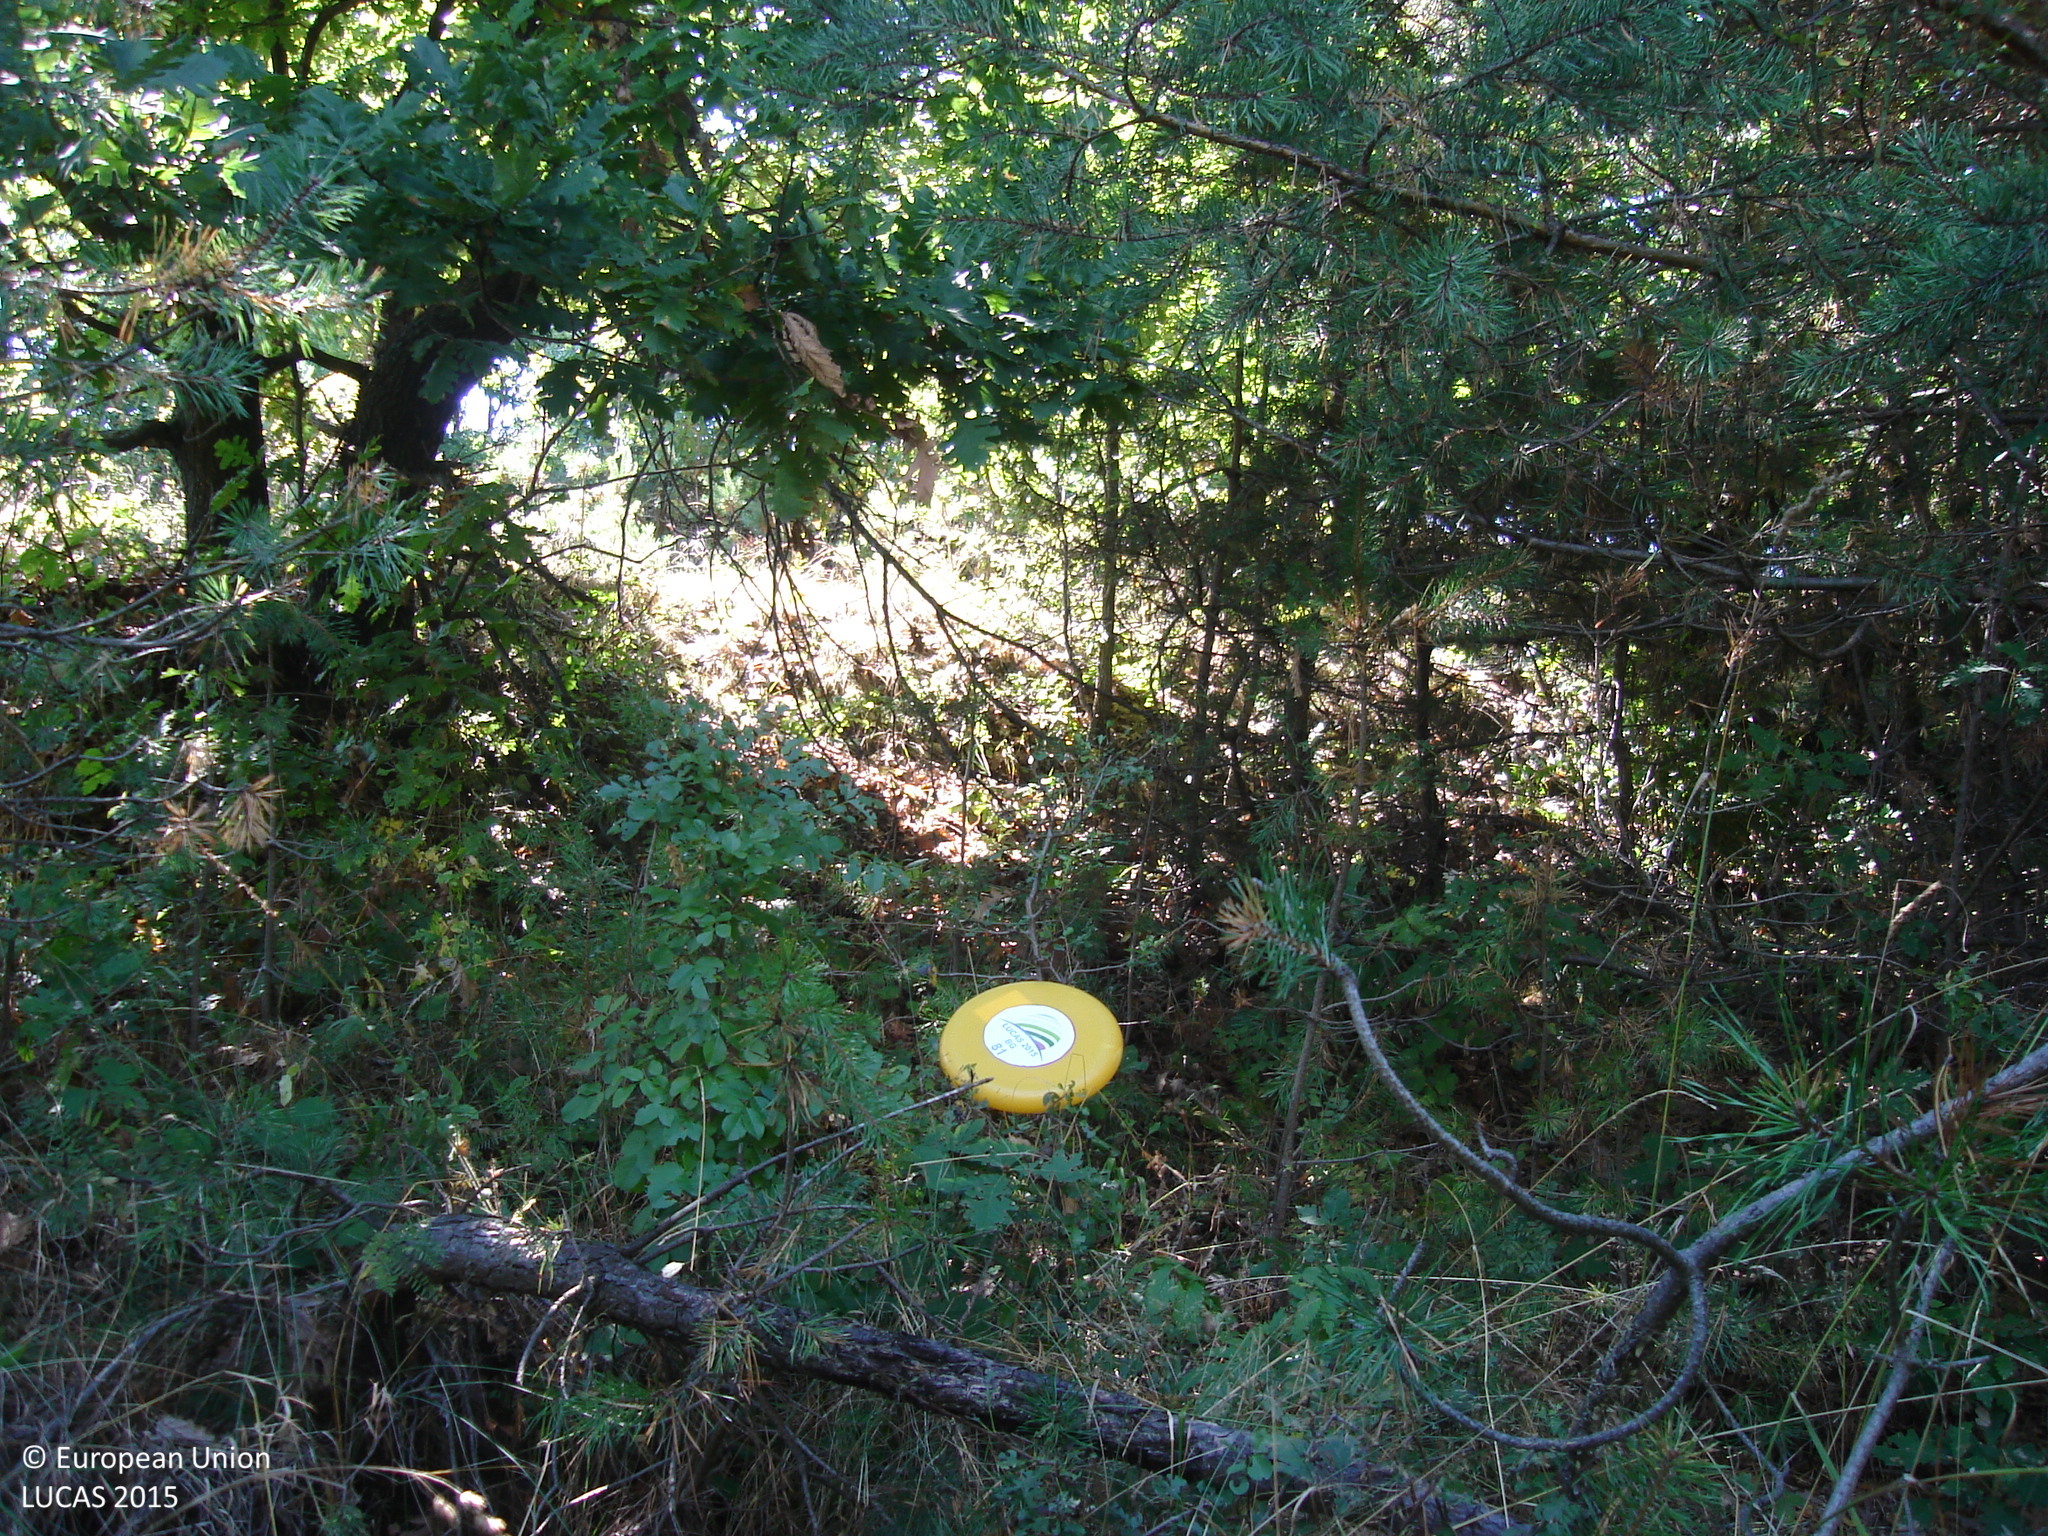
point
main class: Woodland
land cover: Pine dominated mixed woodland
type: hemiboreal forest and nemoral coniferous forest and mixed broadleaved-coniferous forest
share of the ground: > 75 %
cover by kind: coniferous forest trees 55 %, herbaceous plants 25 %, broadleaved forest trees 20 %
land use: Forestry
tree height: > 5 m
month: September
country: BG
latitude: 42.3326
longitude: 23.8864
